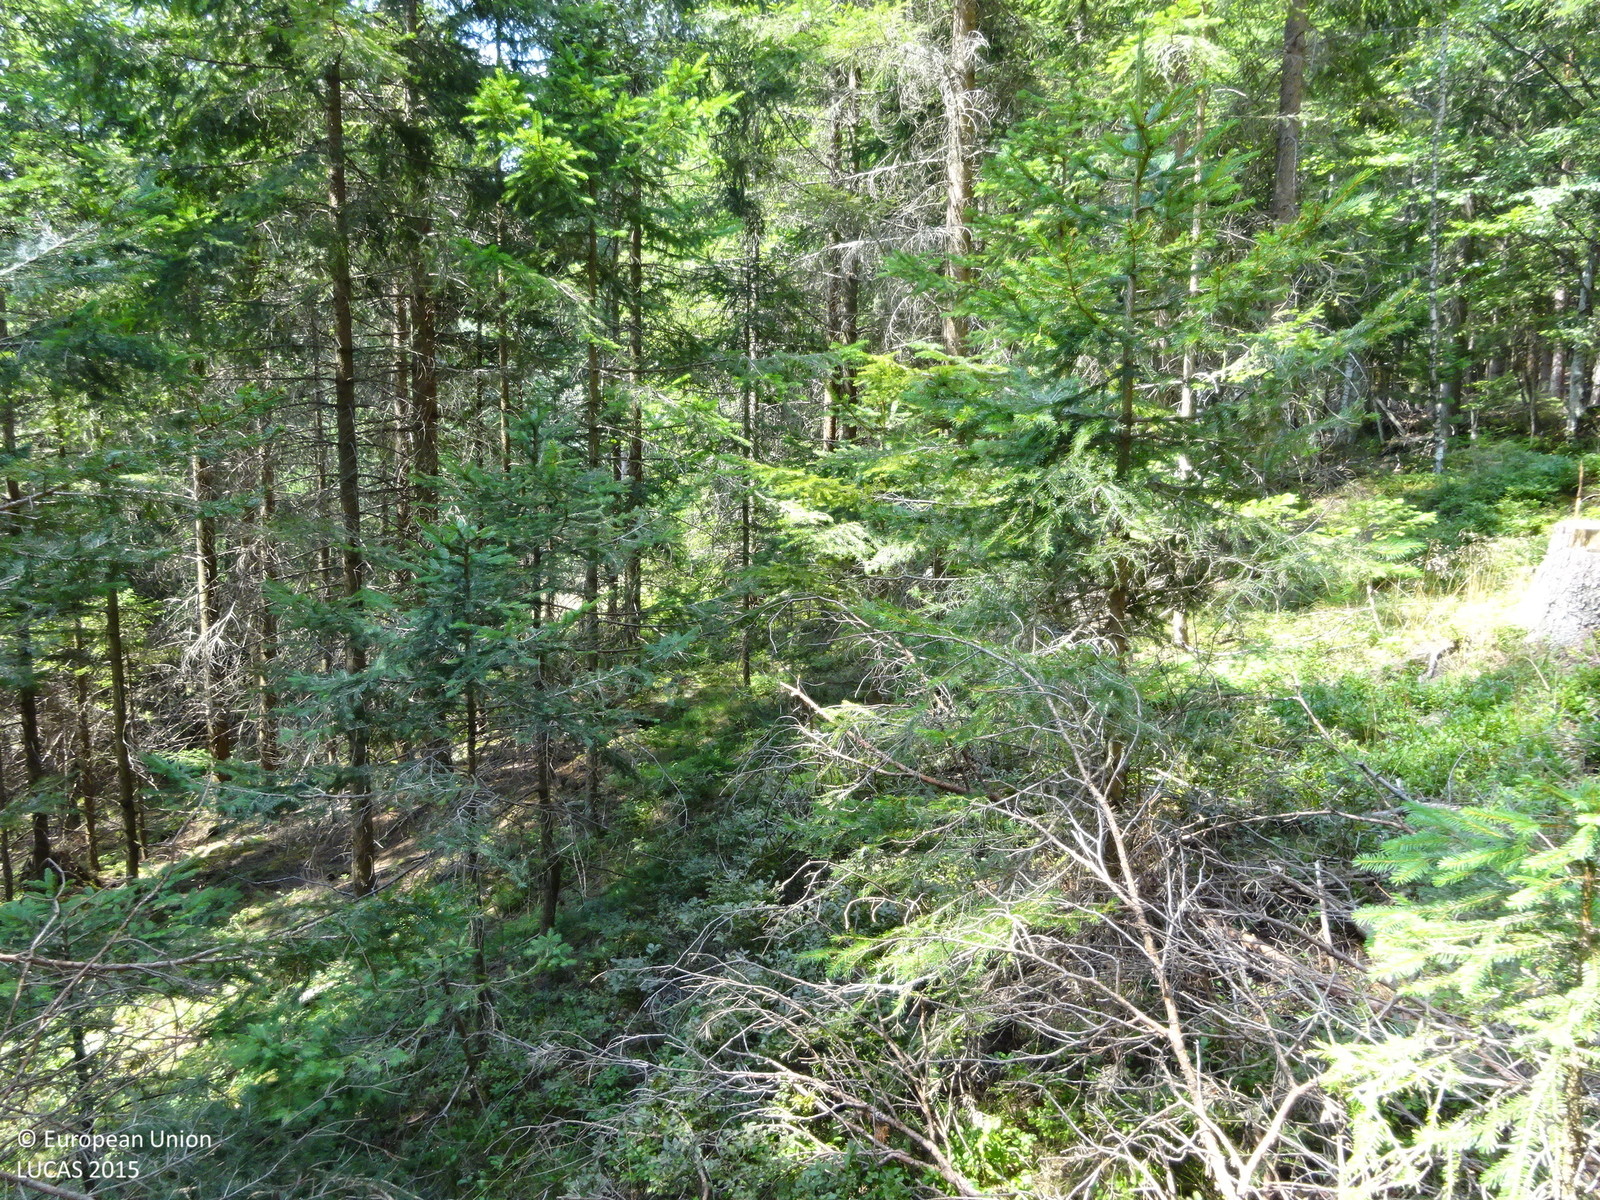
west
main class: Woodland
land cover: Spruce dominated coniferous woodland
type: alpine coniferous forest
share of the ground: > 75 %
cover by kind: coniferous forest trees 75 %, herbaceous plants 20 %, unconsolidated bare surface 5 %
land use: Forestry
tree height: > 5 m
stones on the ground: < 10 %
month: August
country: AT
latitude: 47.4998
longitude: 16.0159
